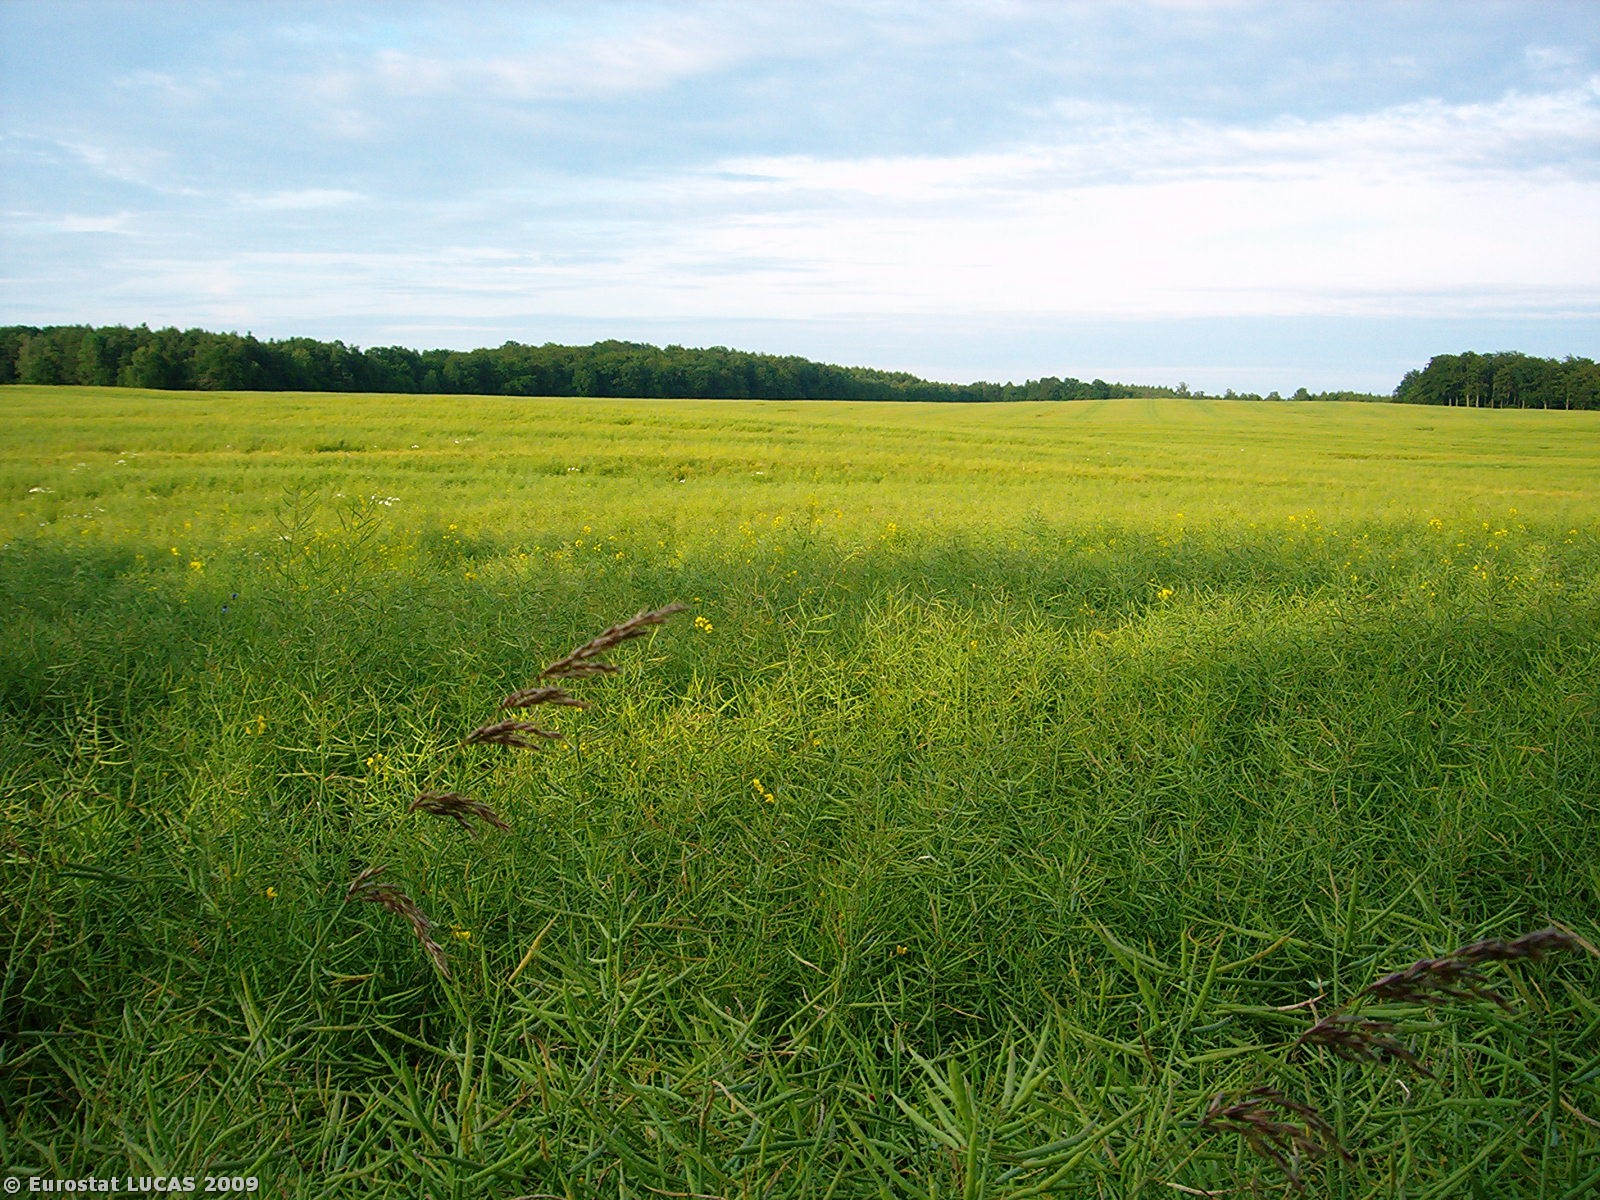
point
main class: Cropland
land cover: Rape and turnip rape
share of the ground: > 75 %
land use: Agriculture (excluding fallow land and kitchen gardens)
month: June
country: PL
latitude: 54.0206
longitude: 15.3905
